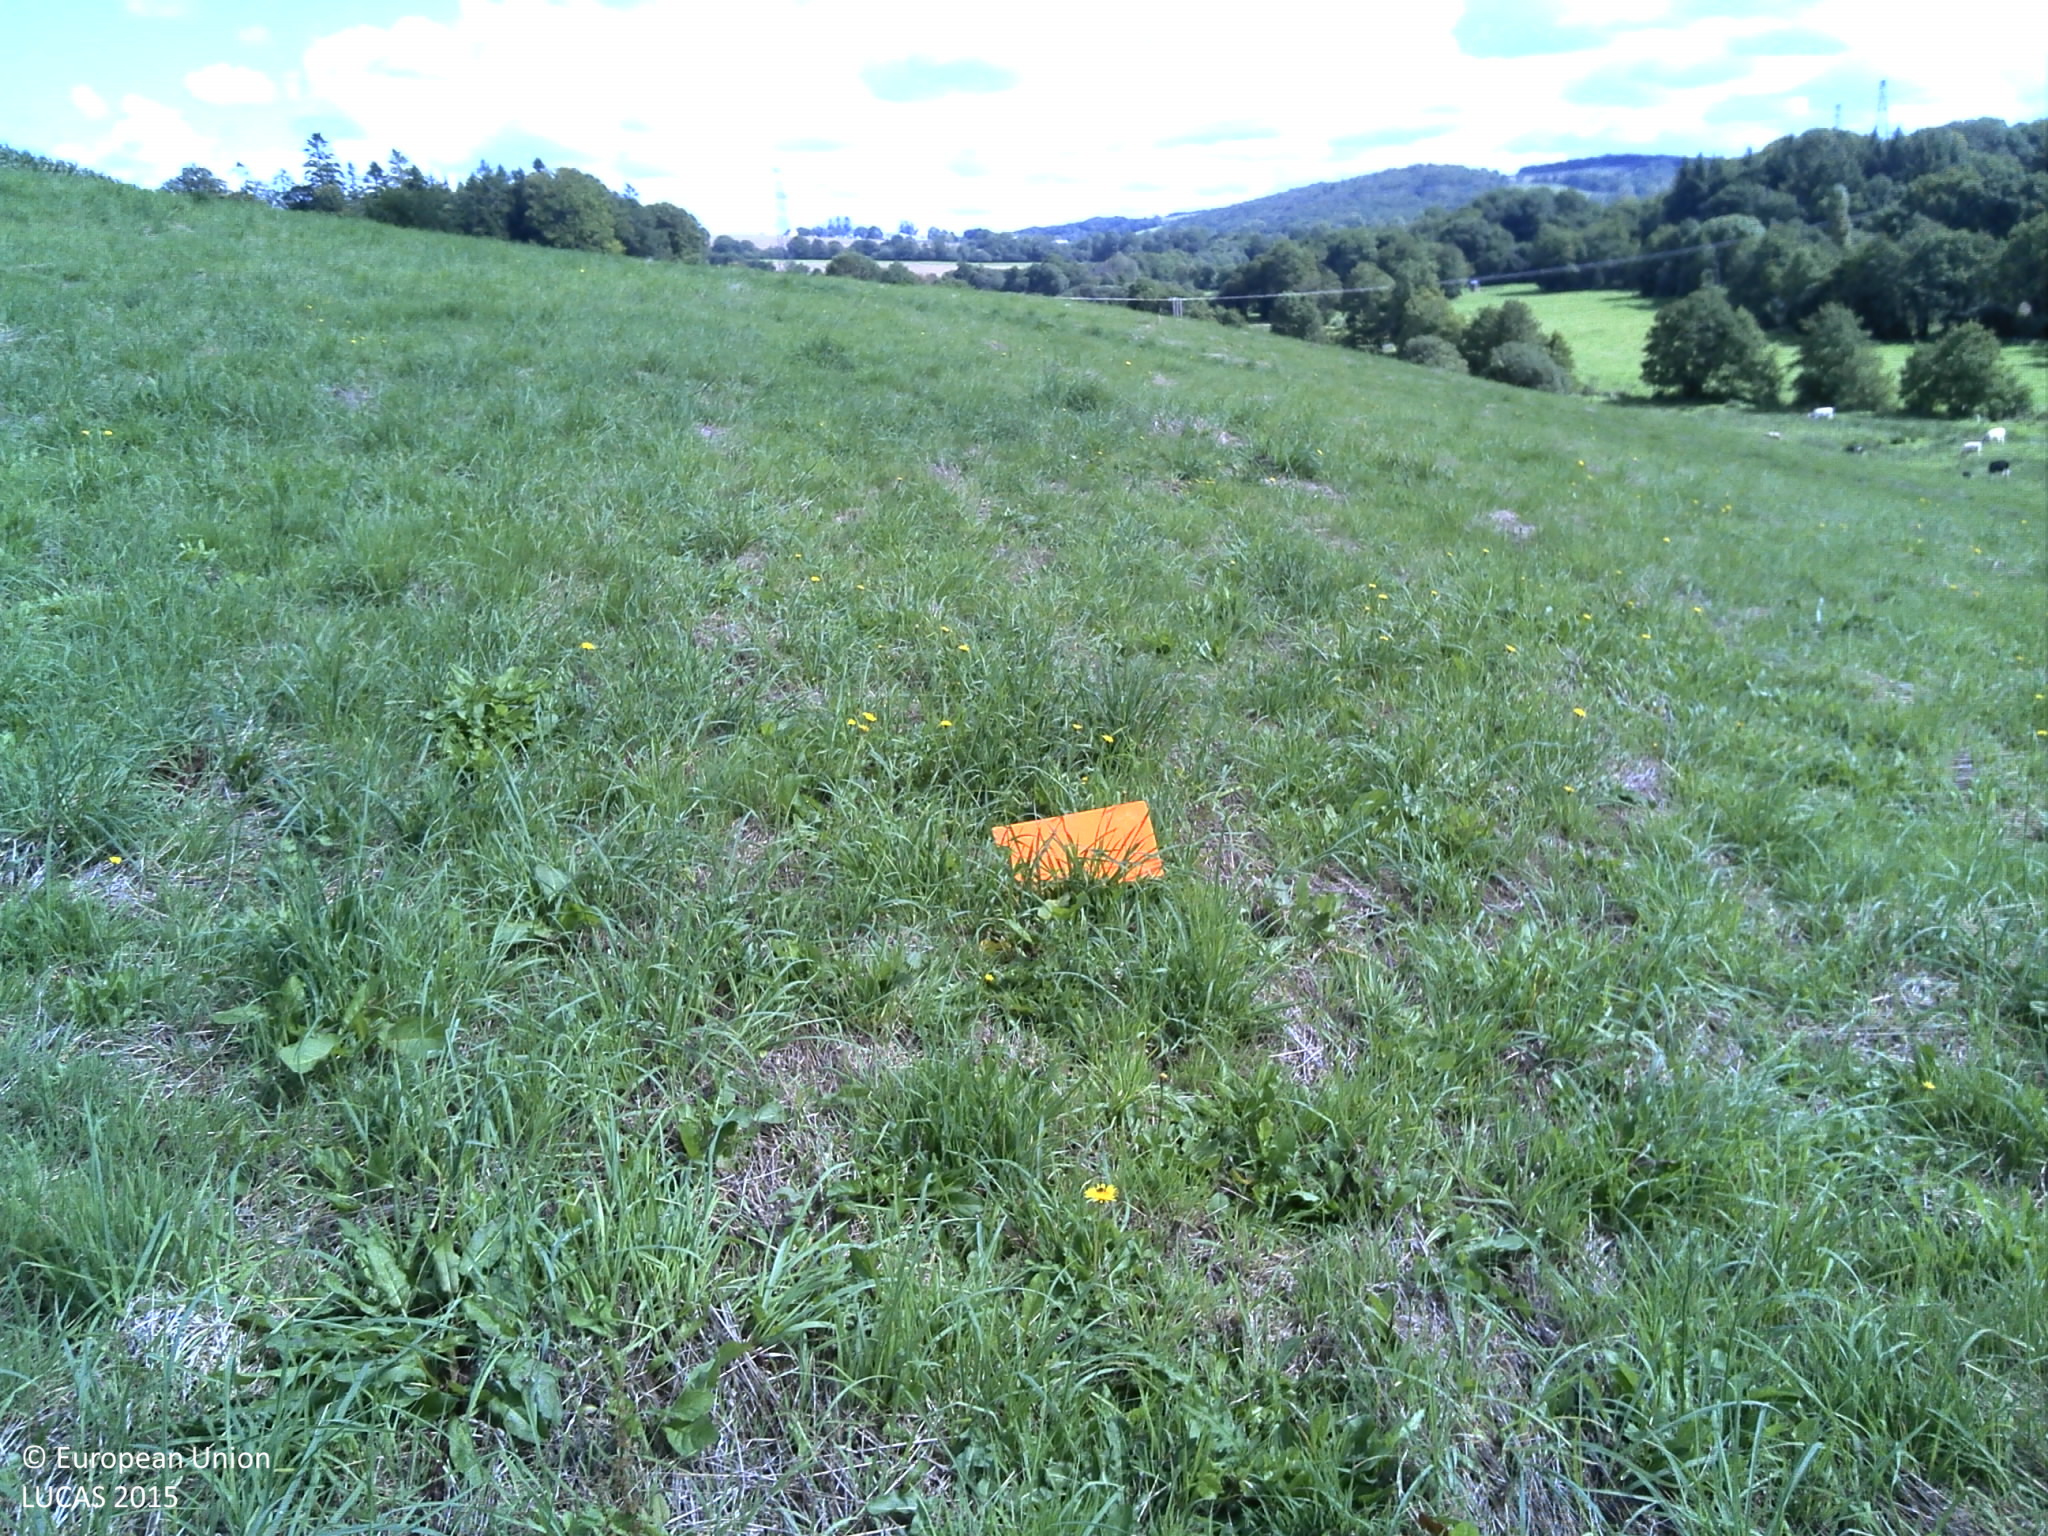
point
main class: Grassland
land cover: Grassland without tree/shrub cover
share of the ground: > 75 %
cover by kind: herbaceous plants 100 %
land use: Agriculture (excluding fallow land and kitchen gardens)
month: September
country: FR
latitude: 48.3972
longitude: -4.1790
